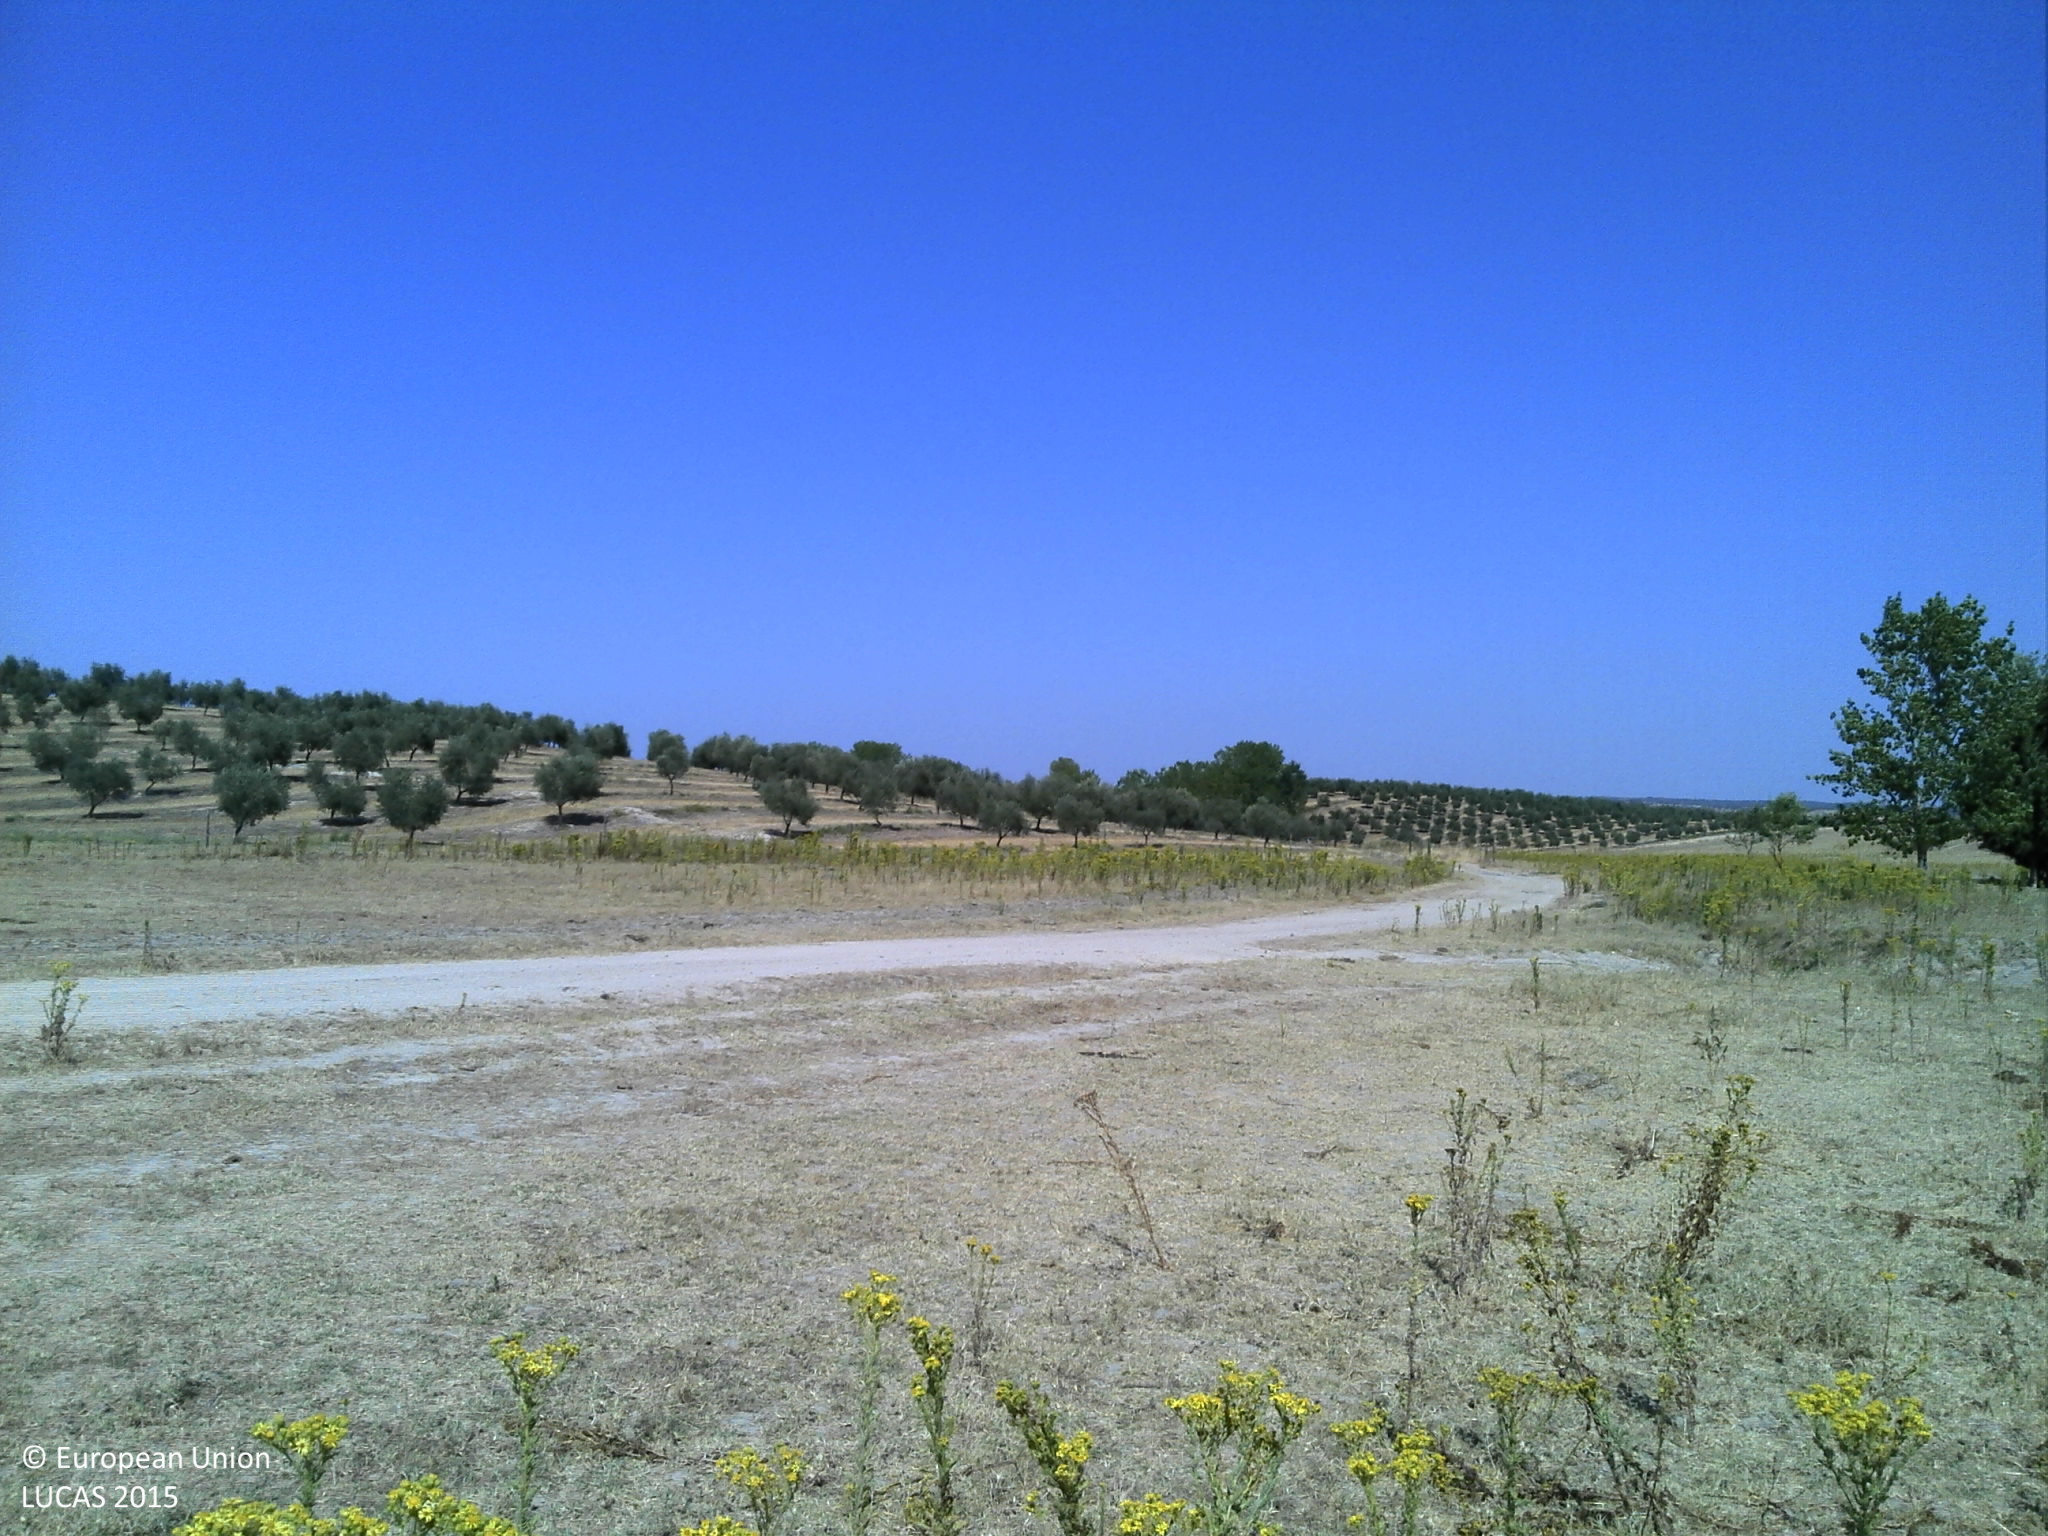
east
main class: Grassland
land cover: Grassland without tree/shrub cover
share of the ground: 25 - 50 %
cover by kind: unconsolidated bare surface 75 %, herbaceous plants 25 %
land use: Agriculture (excluding fallow land and kitchen gardens)
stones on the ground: < 10 %
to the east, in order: Grassland without tree/shrub cover; Tracks; Ditches and canals; Grassland without tree/shrub cover; Rivers and streams; Fences; Grassland without tree/shrub cover; Olive groves; Ditches and canals; Tracks
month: July
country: PT
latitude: 38.5699
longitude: -7.6983
